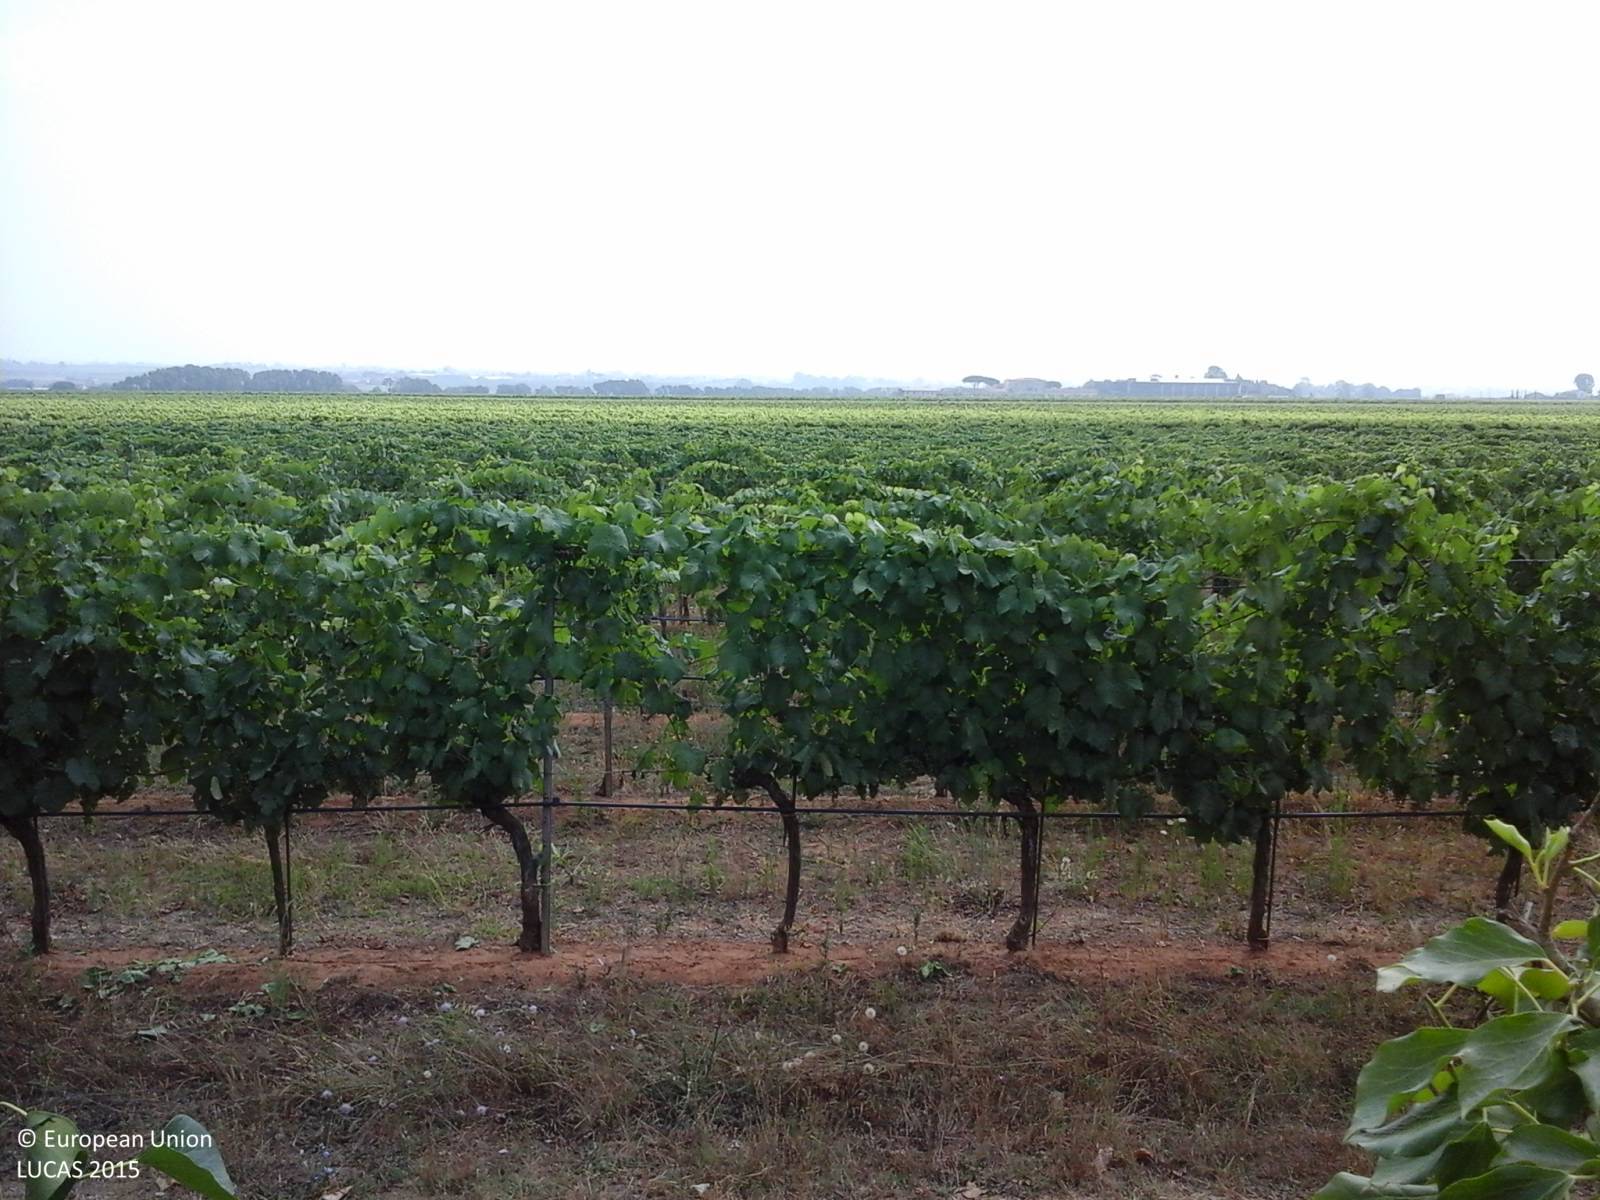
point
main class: Cropland
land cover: Vineyards
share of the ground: > 75 %
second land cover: Spontaneously vegetated surfaces
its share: > 75 %
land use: Agriculture (excluding fallow land and kitchen gardens)
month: July
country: IT
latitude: 41.5143
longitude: 12.7330
